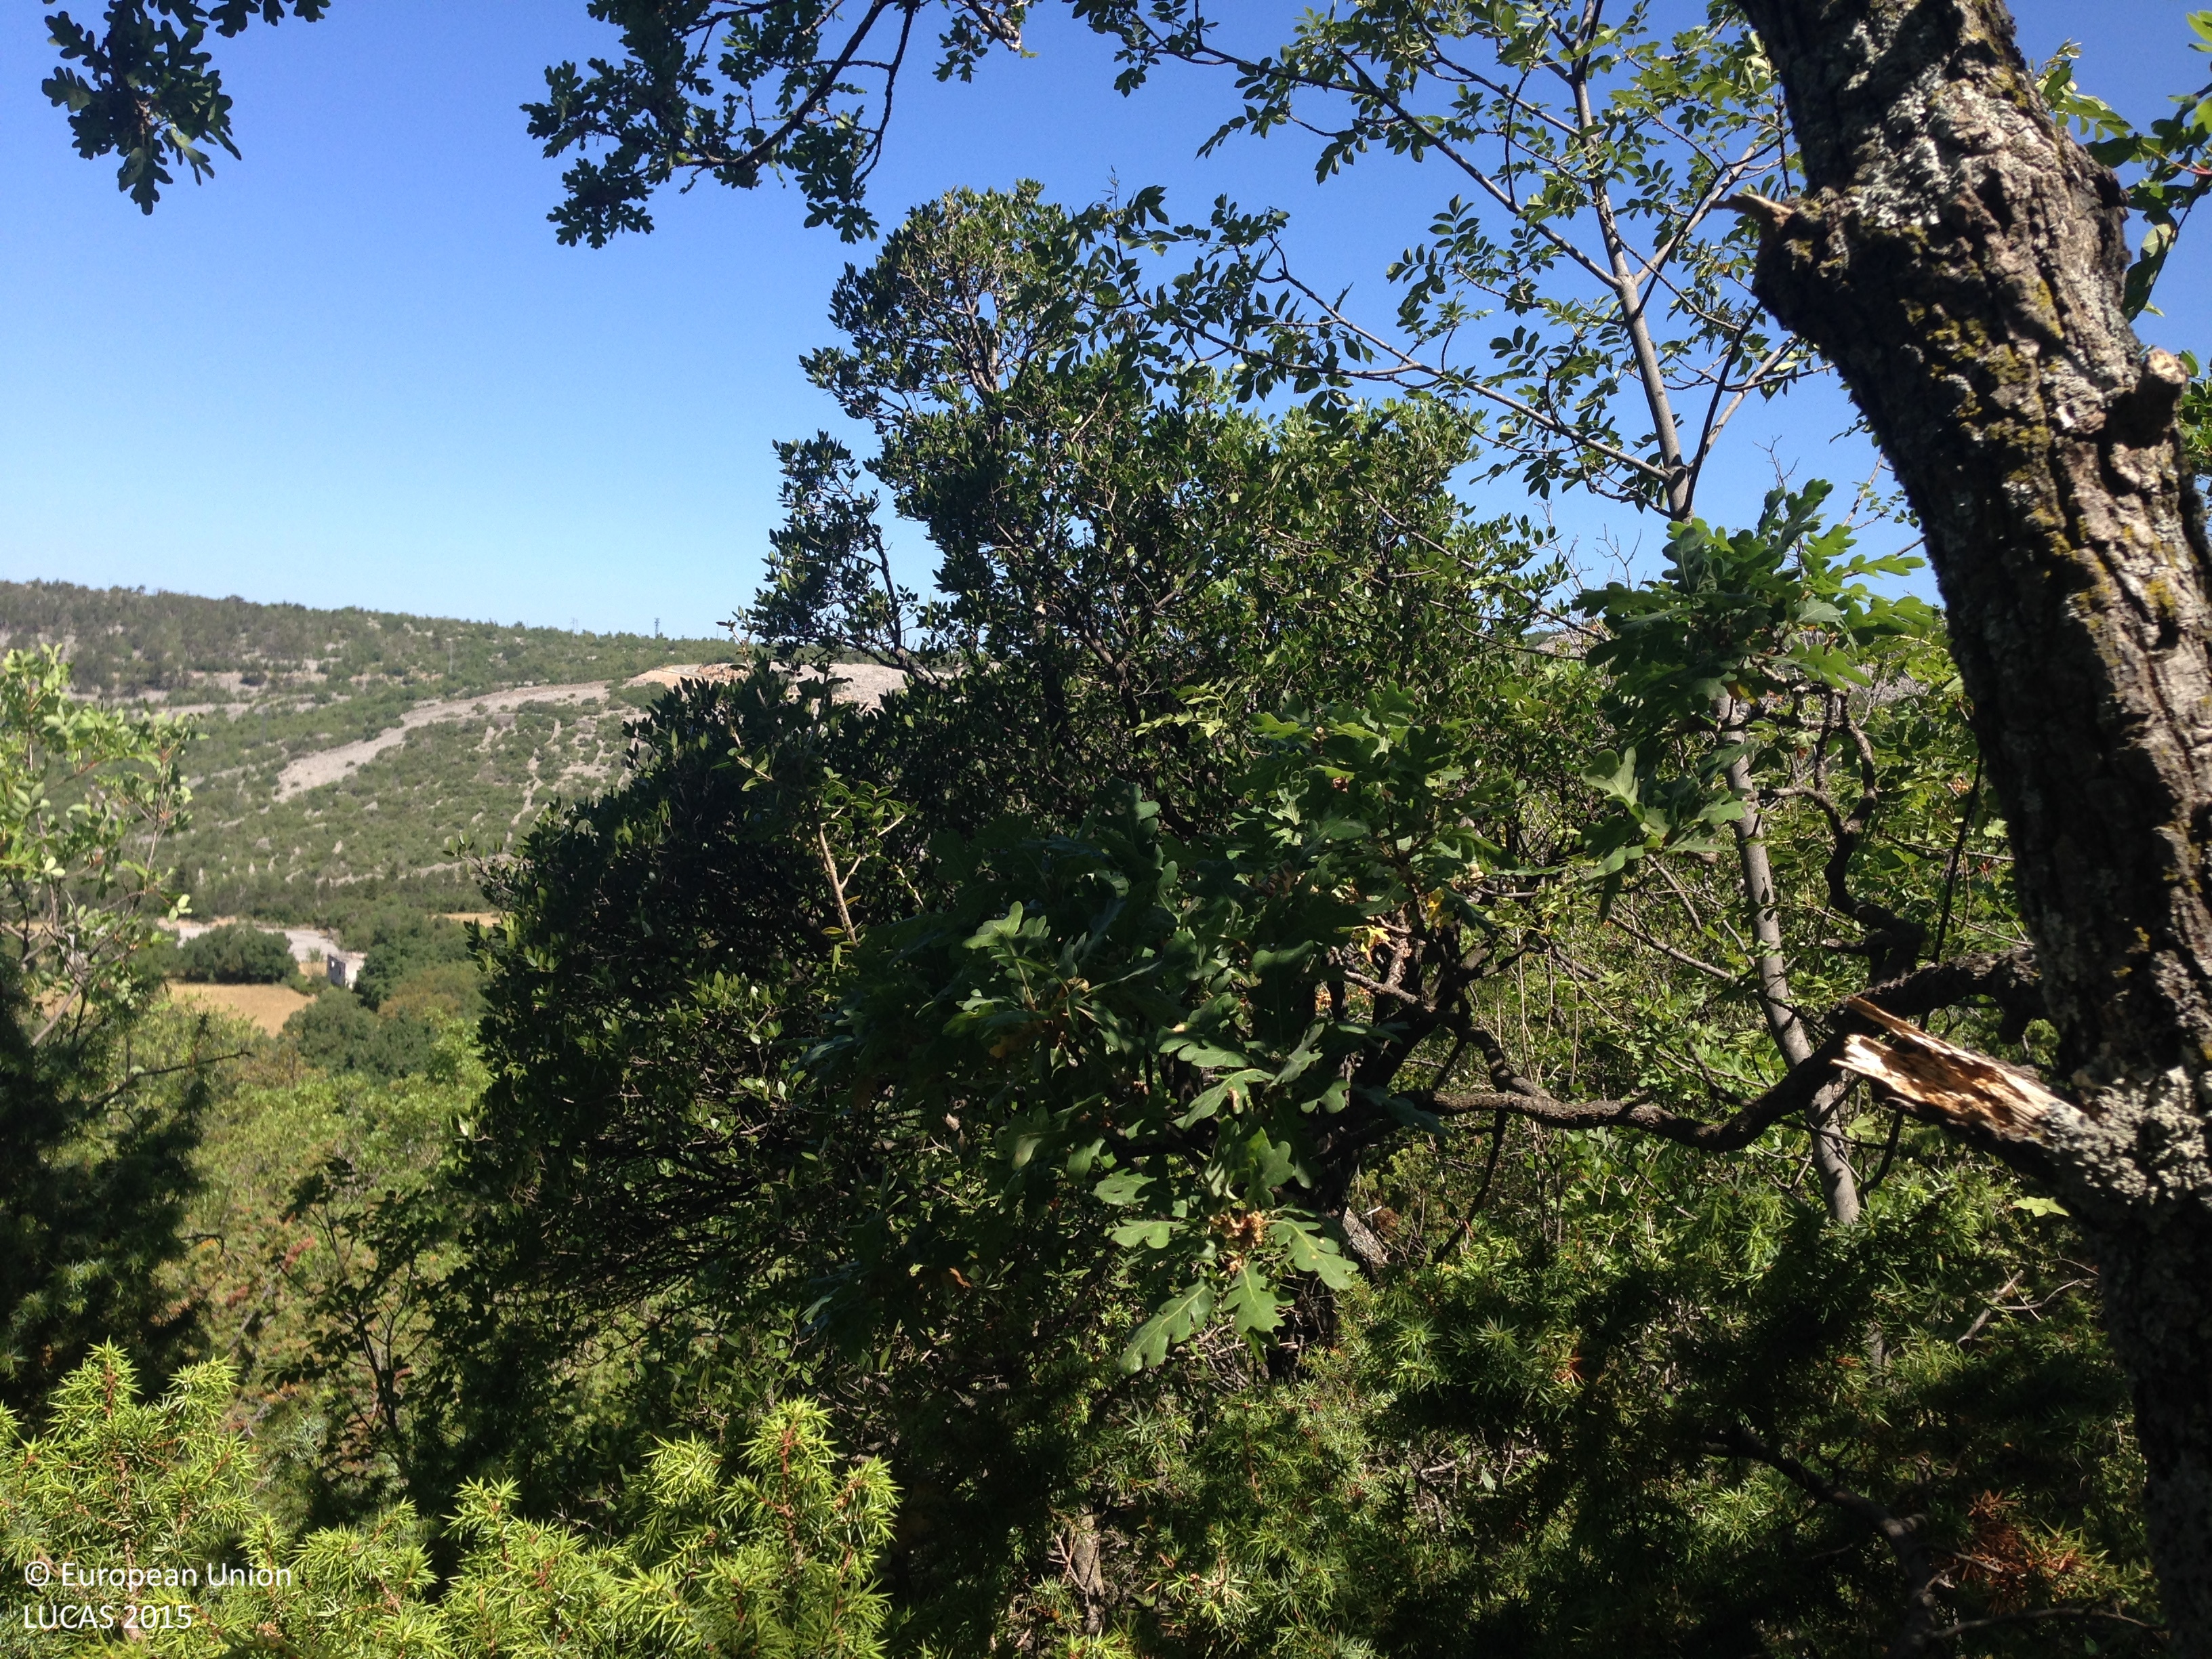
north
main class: Woodland
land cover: Broadleaved woodland
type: thermophilous deciduous forest
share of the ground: 25 - 50 %
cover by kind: broadleaved forest trees 35 %, shrubs 20 %, herbaceous plants 20 %, consolidated bare surface 20 %, unconsolidated bare surface 5 %
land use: Semi-natural and natural areas not in use
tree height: < 5 m
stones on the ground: 10 - 25 %
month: July
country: HR
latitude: 44.7043
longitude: 14.9032
